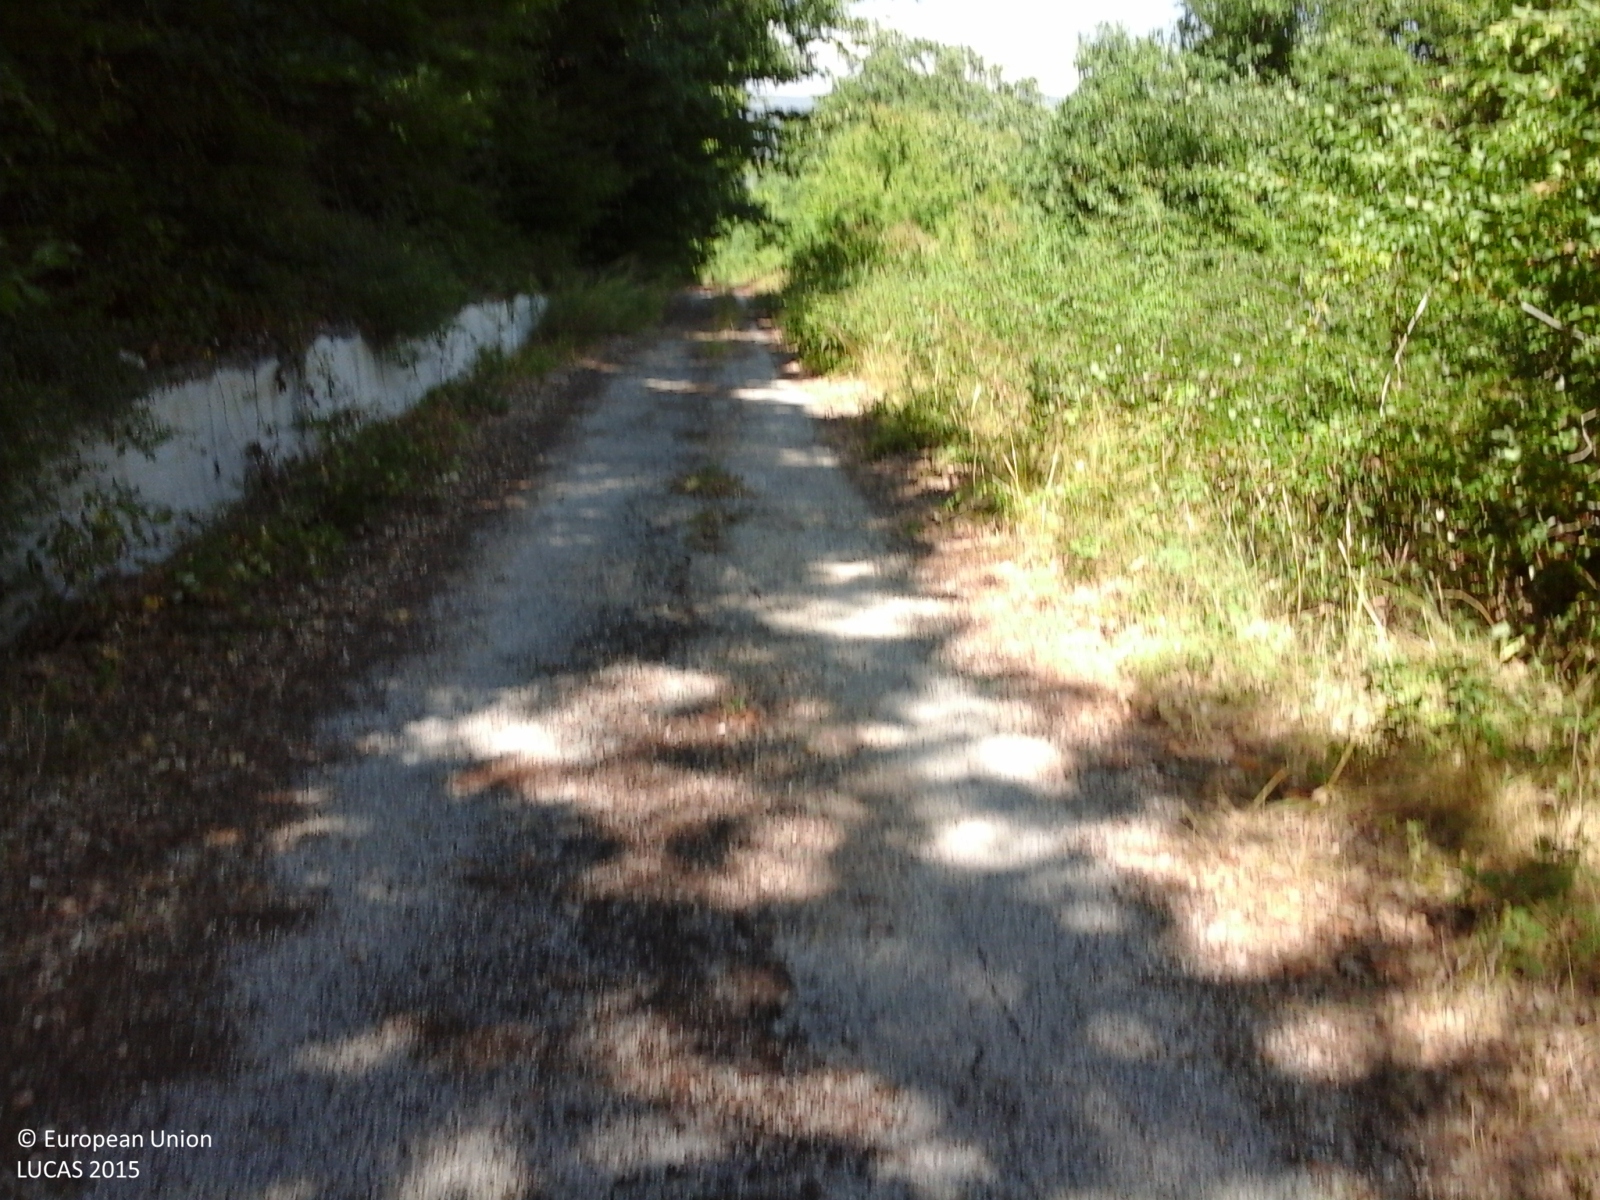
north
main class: Woodland
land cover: Broadleaved woodland
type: thermophilous deciduous forest
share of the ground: > 75 %
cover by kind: broadleaved forest trees 90 %, shrubs 5 %, herbaceous plants 5 %
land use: Semi-natural and natural areas not in use
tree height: > 5 m
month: September
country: IT
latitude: 41.6815
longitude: 14.1778
